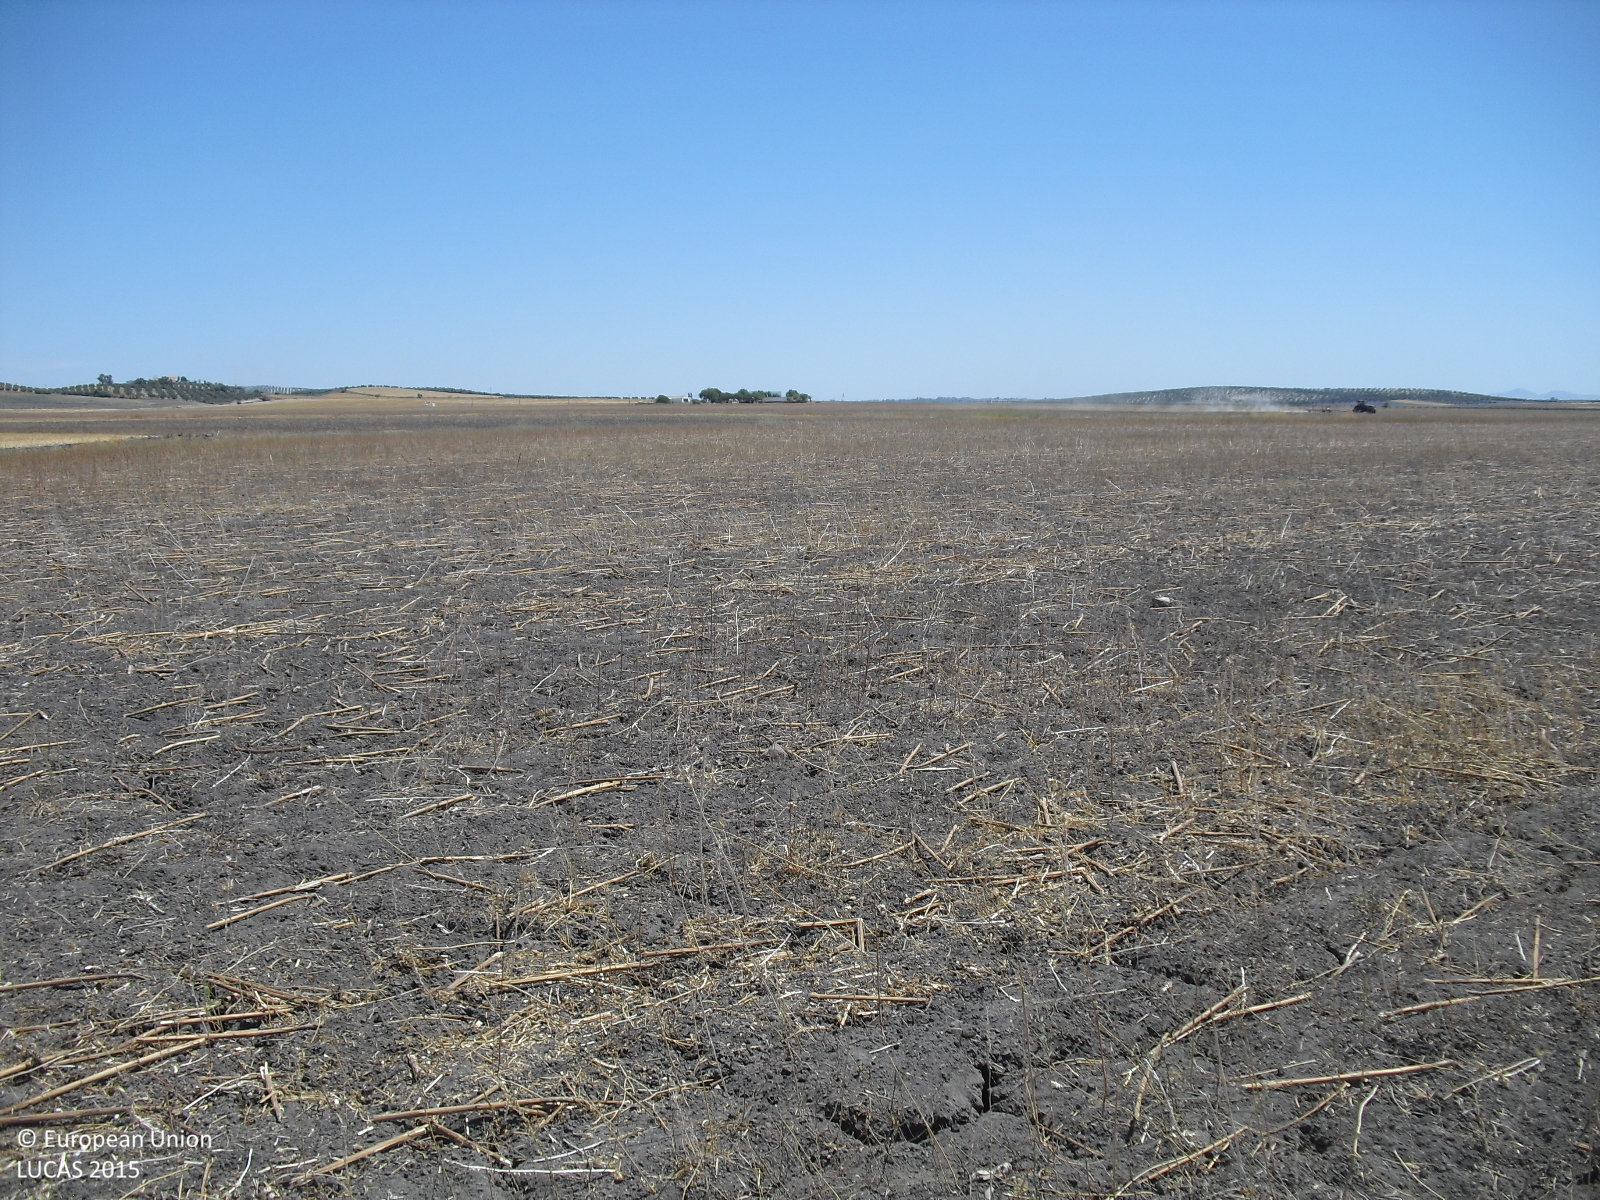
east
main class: Cropland
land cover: Sunflower
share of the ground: < 10 %
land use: Agriculture (excluding fallow land and kitchen gardens)
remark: Harvested field
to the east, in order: Sunflower; Grassland without tree/shrub cover; Rivers and streams; Grass margins; Sunflower
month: August
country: ES
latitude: 37.3286
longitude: -5.5333
